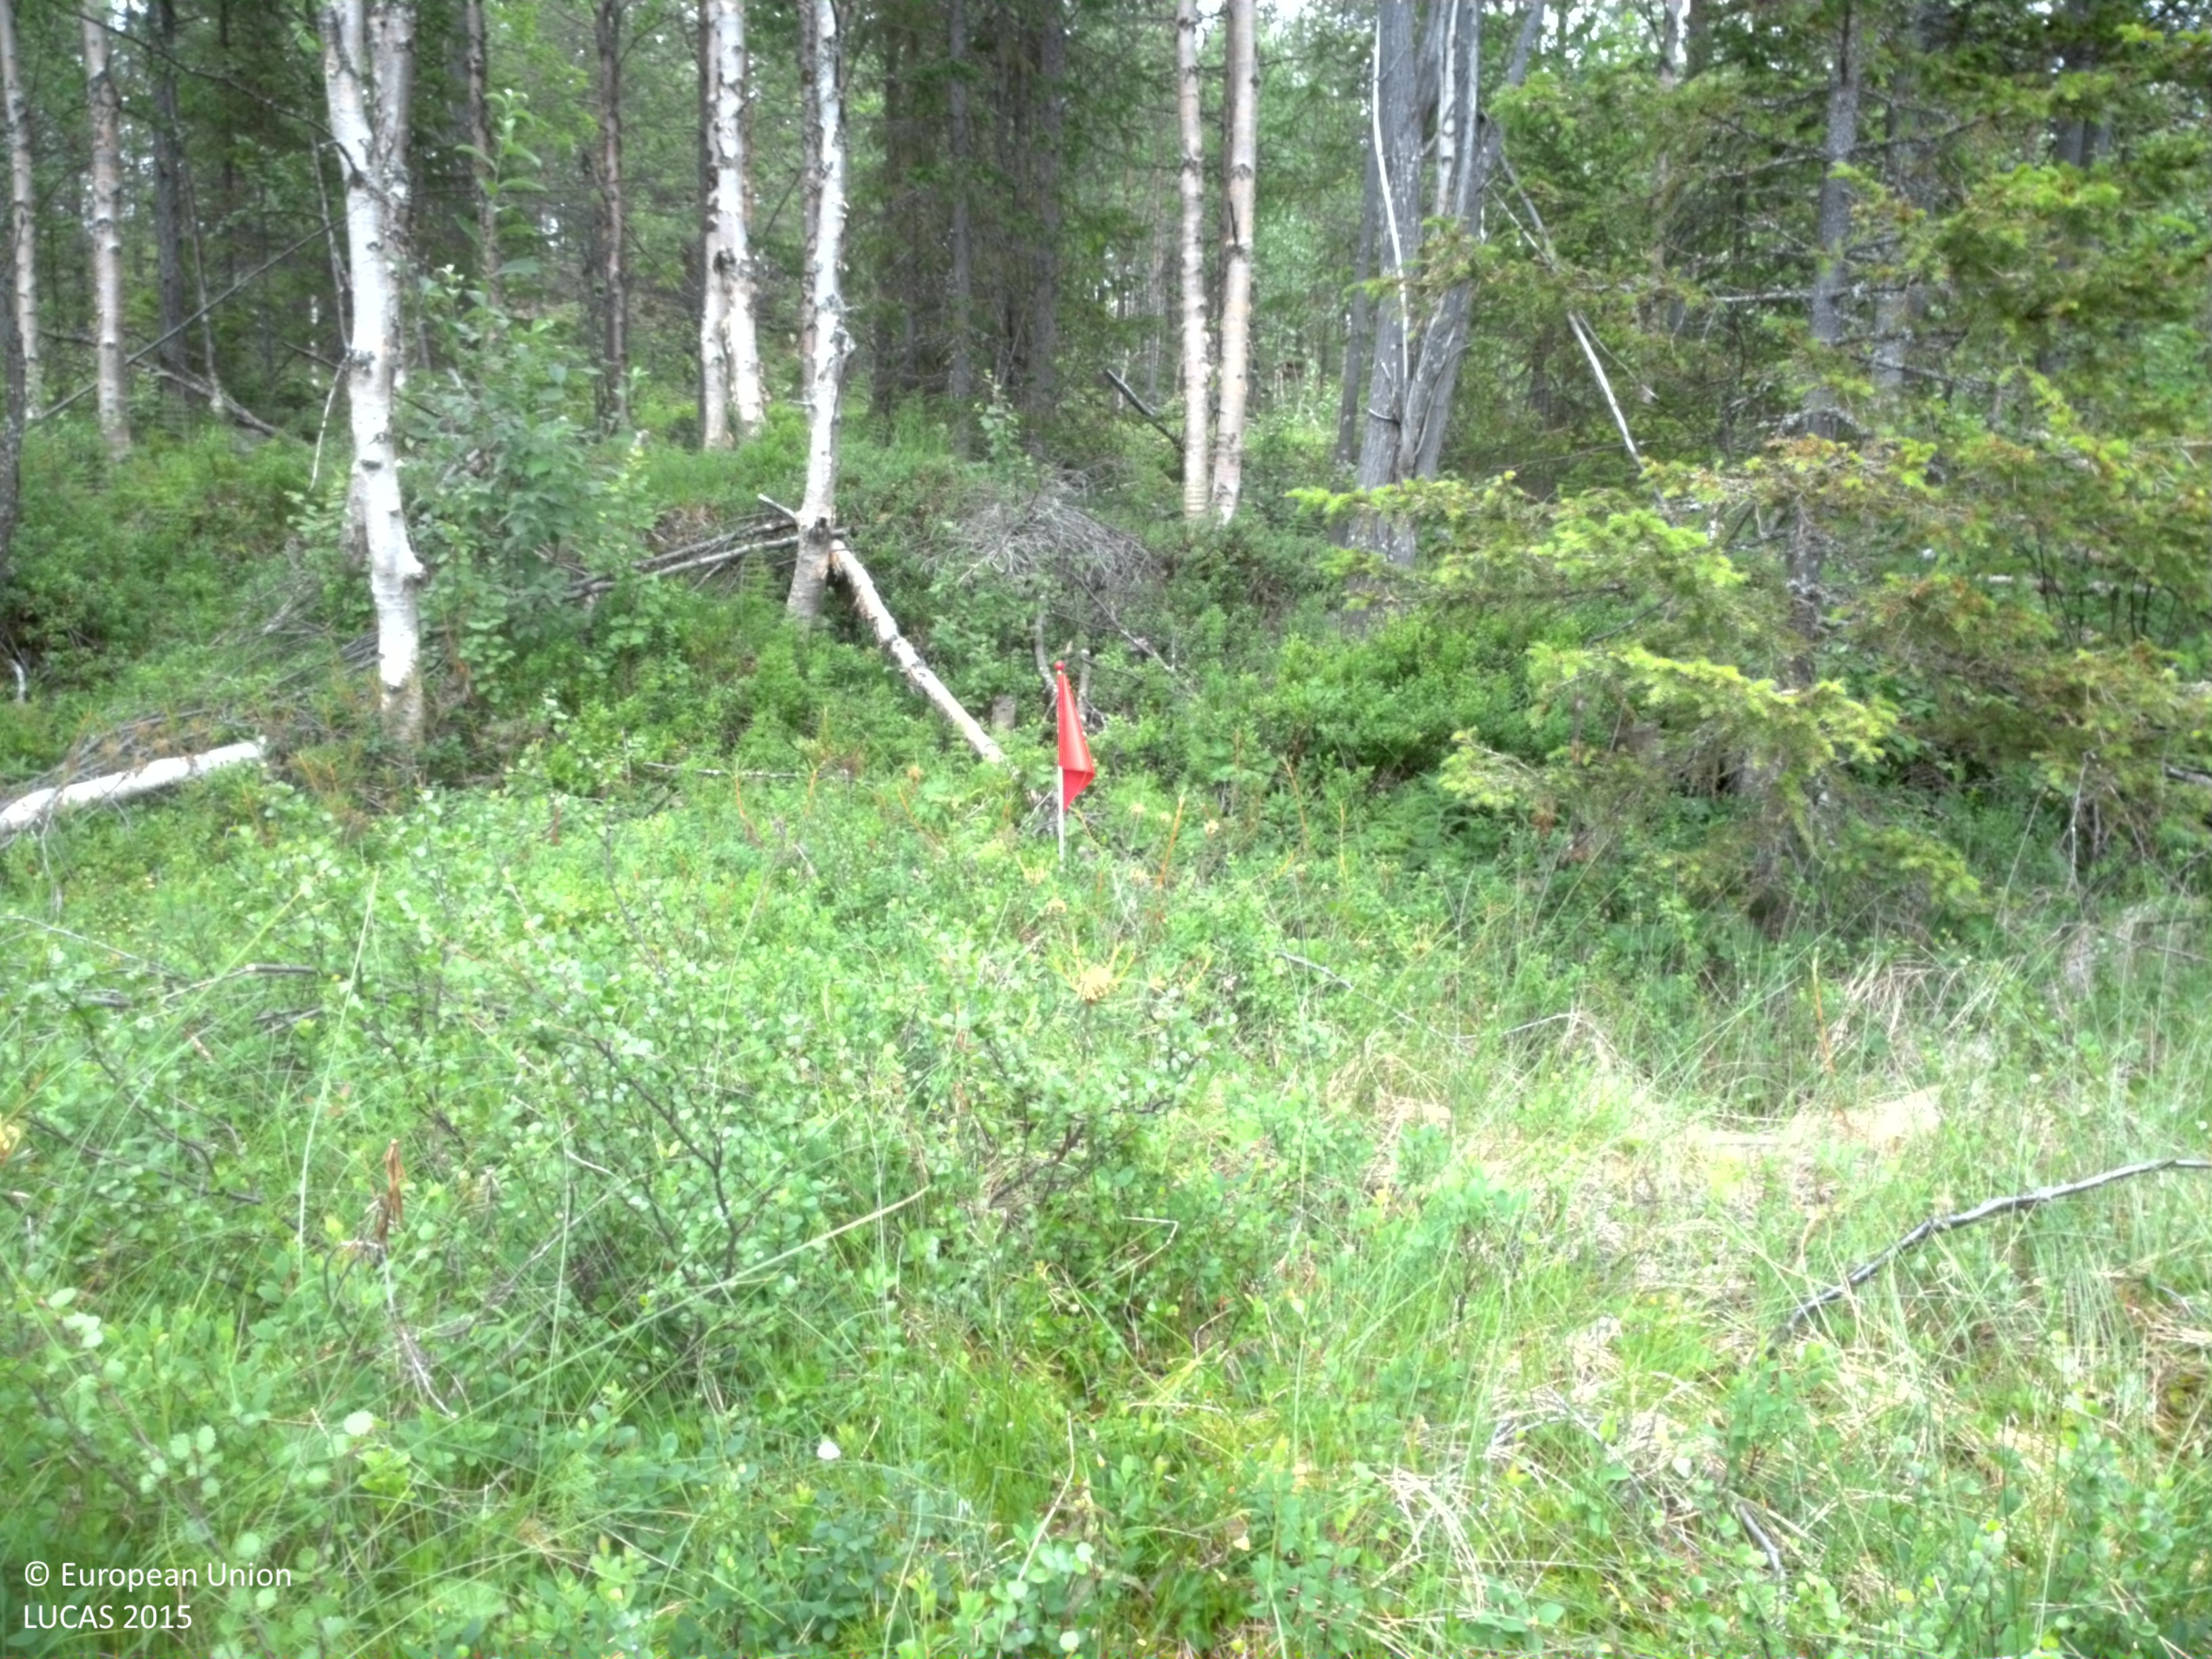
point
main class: Woodland
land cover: Pine dominated mixed woodland
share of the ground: 25 - 50 %
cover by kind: shrubs 50 %, broadleaved forest trees 30 %, coniferous forest trees 20 %
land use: Forestry
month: August
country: SE
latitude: 66.1875
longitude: 19.8786
